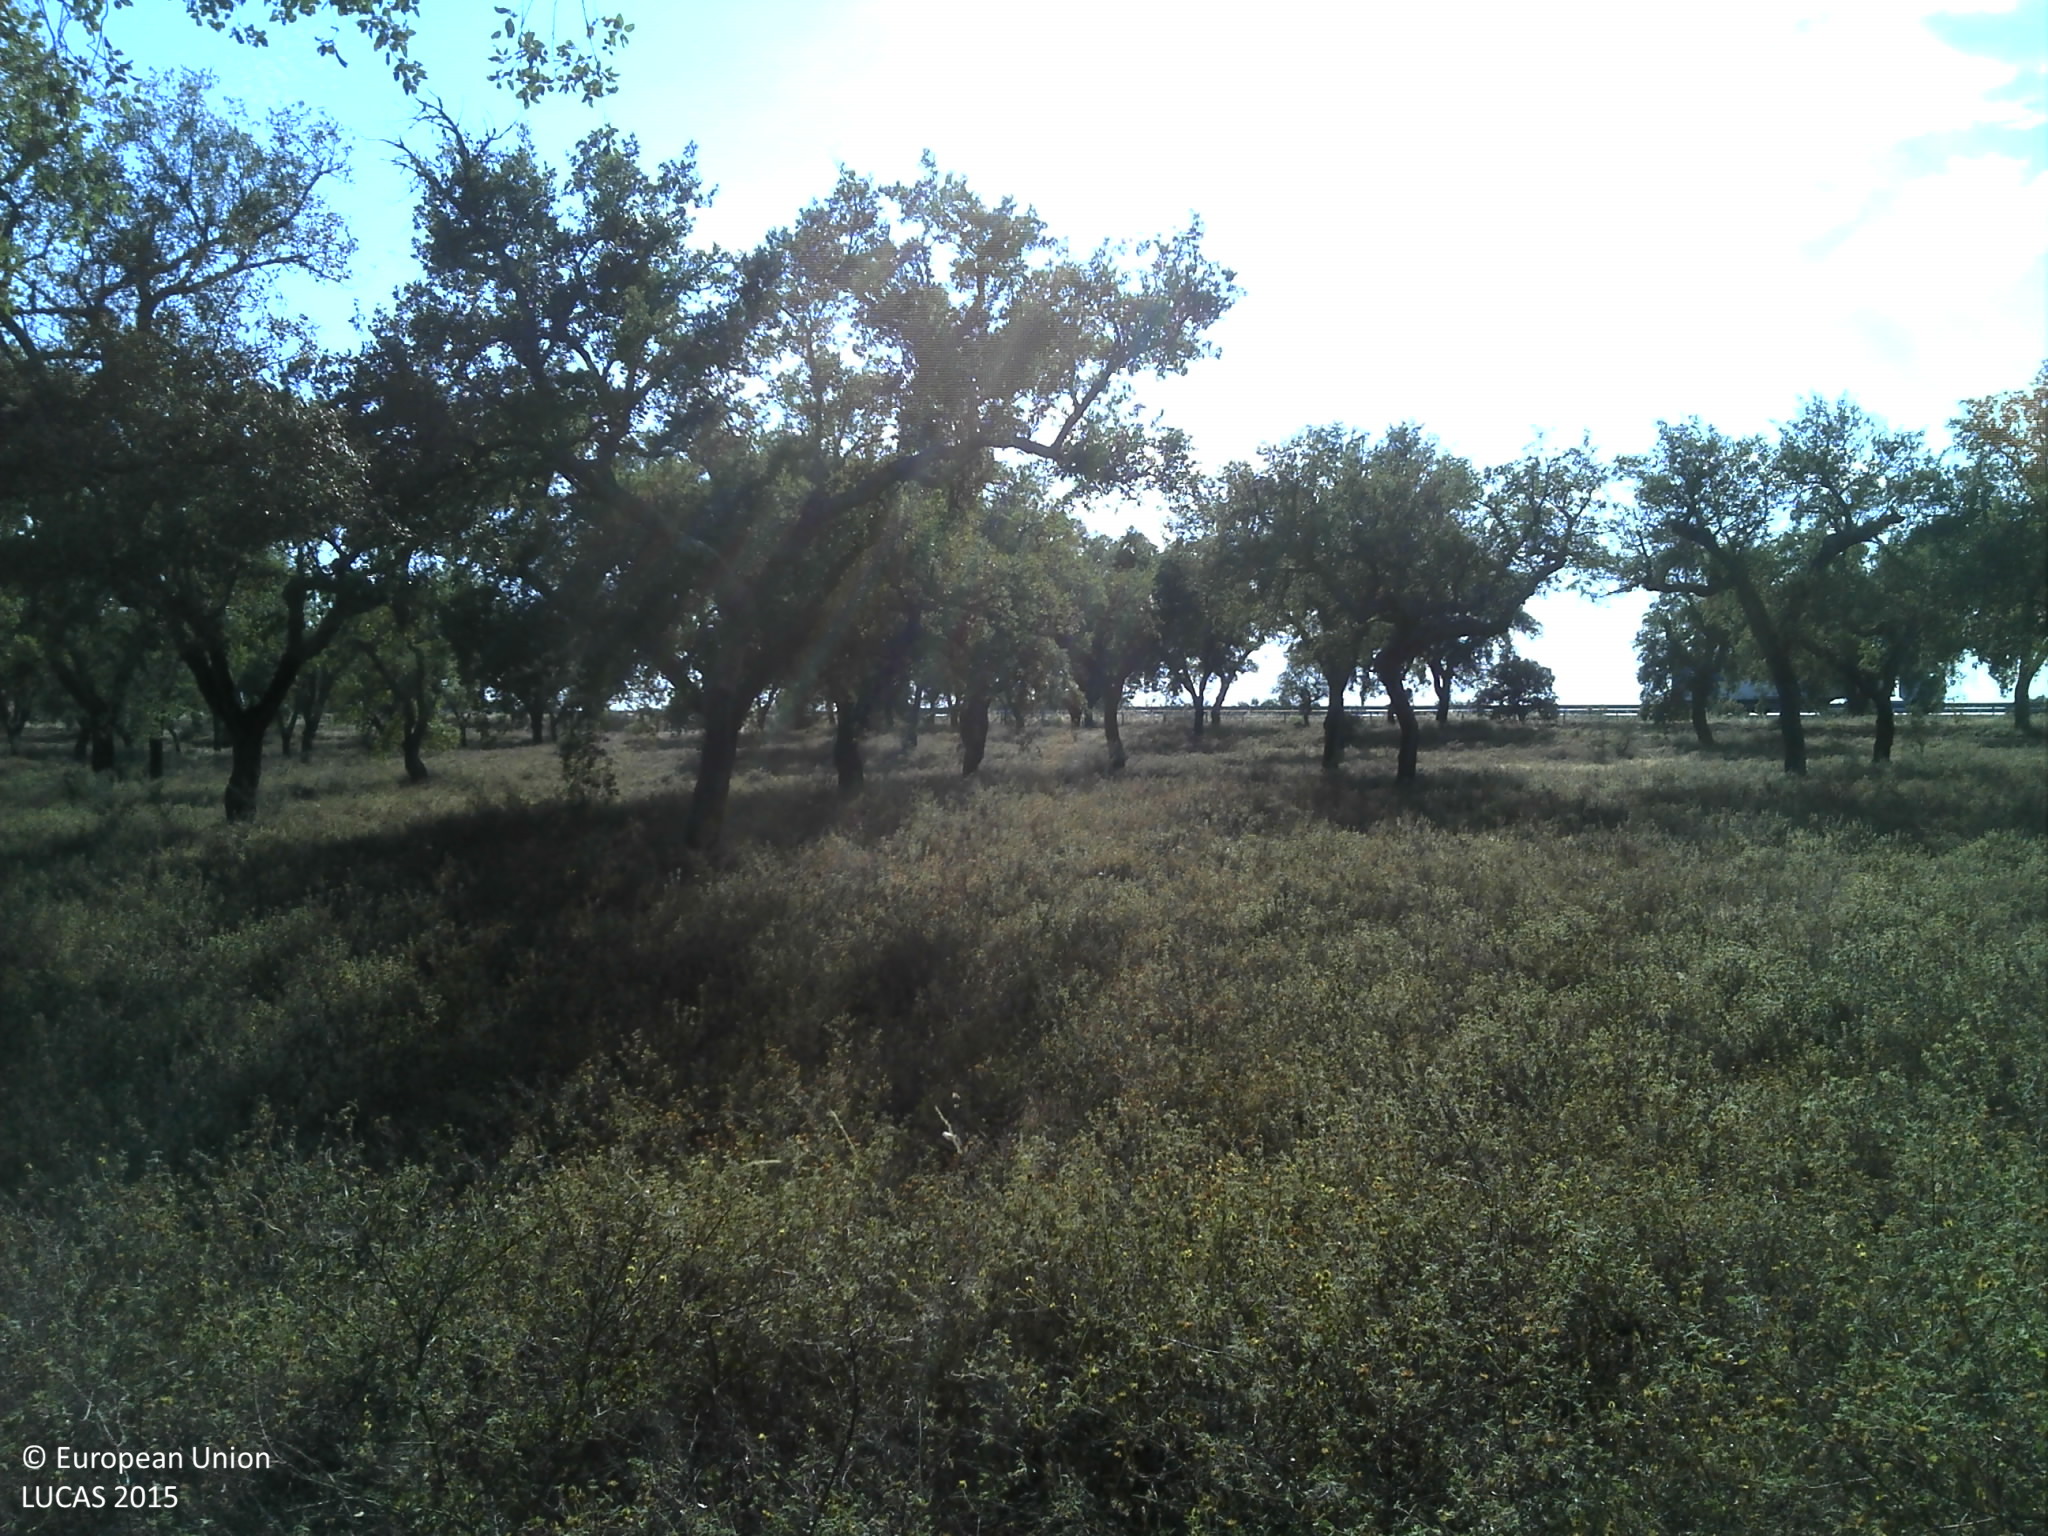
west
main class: Woodland
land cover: Broadleaved woodland
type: broadleaved evergreen forest
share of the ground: 25 - 50 %
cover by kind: broadleaved forest trees 50 %, shrubs 40 %, herbaceous plants 10 %
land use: Forestry
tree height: > 5 m
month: June
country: PT
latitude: 38.6979
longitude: -7.8037
